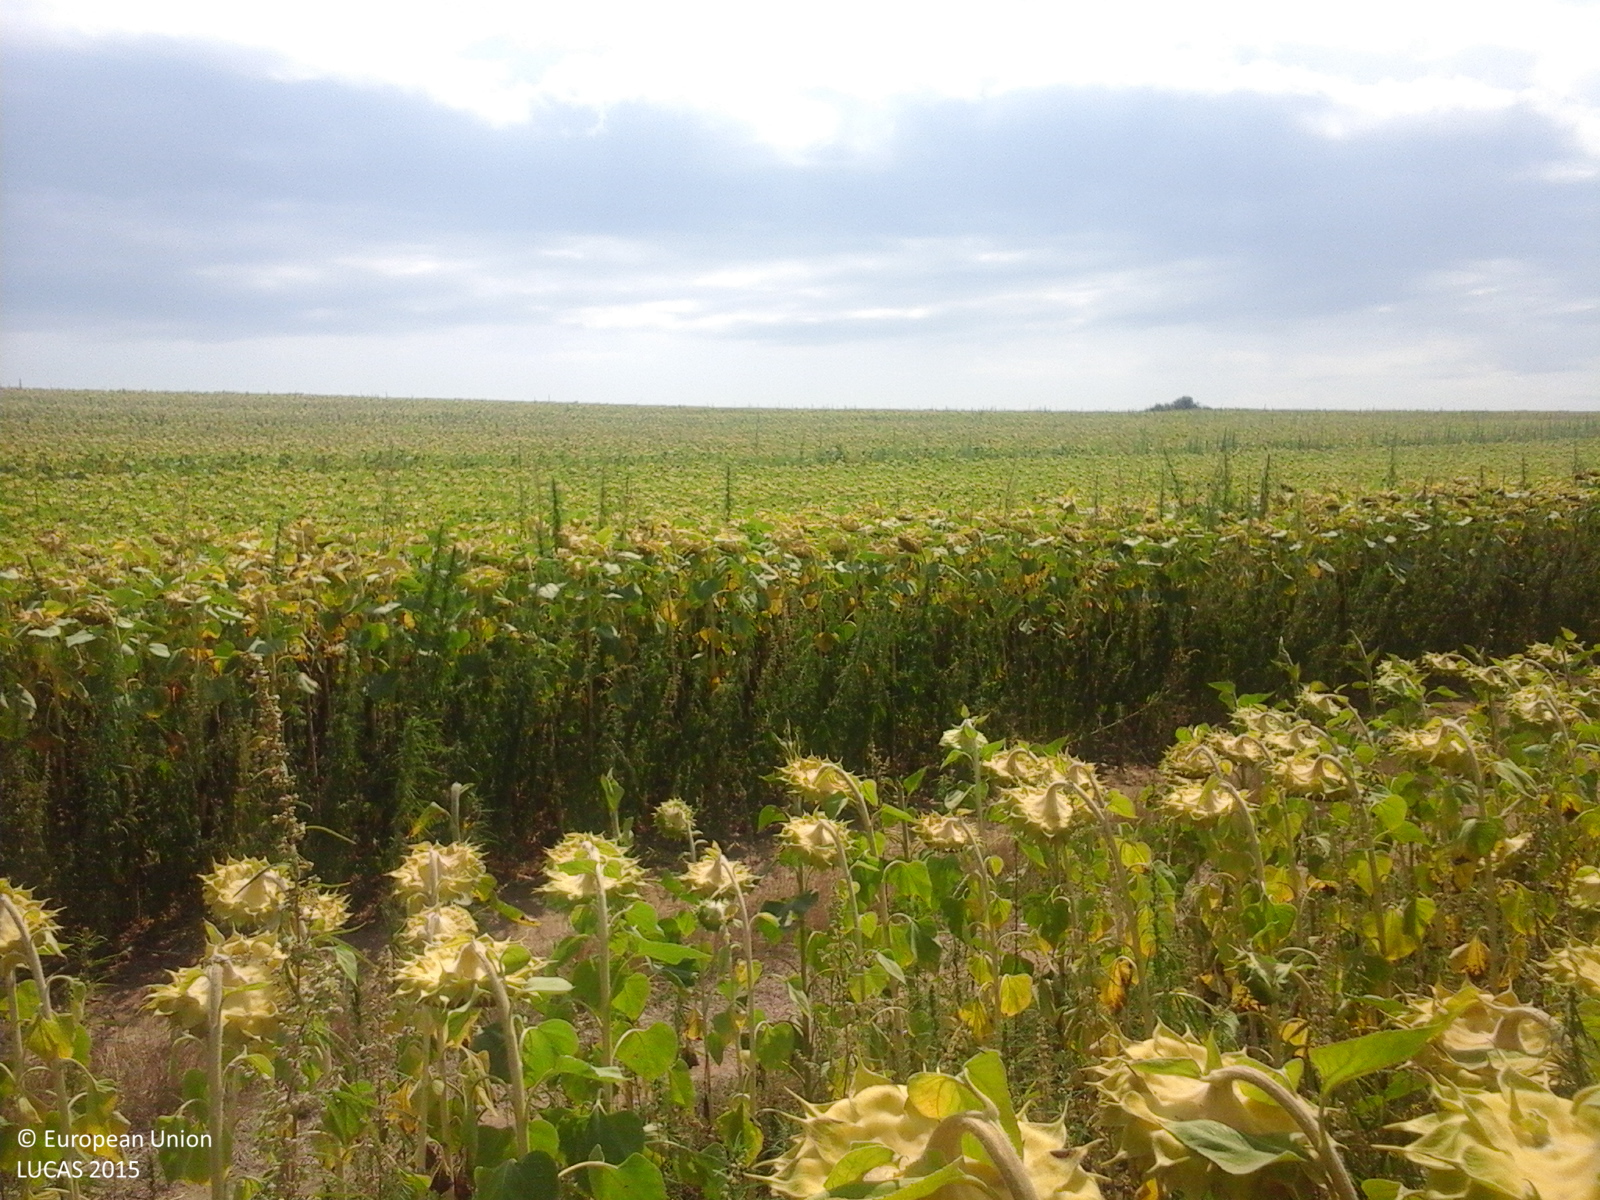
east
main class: Cropland
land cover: Sunflower
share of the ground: > 75 %
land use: Agriculture (excluding fallow land and kitchen gardens)
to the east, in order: Sunflower; Tracks; Sunflower
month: August
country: RO
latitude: 44.0005
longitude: 27.7664
